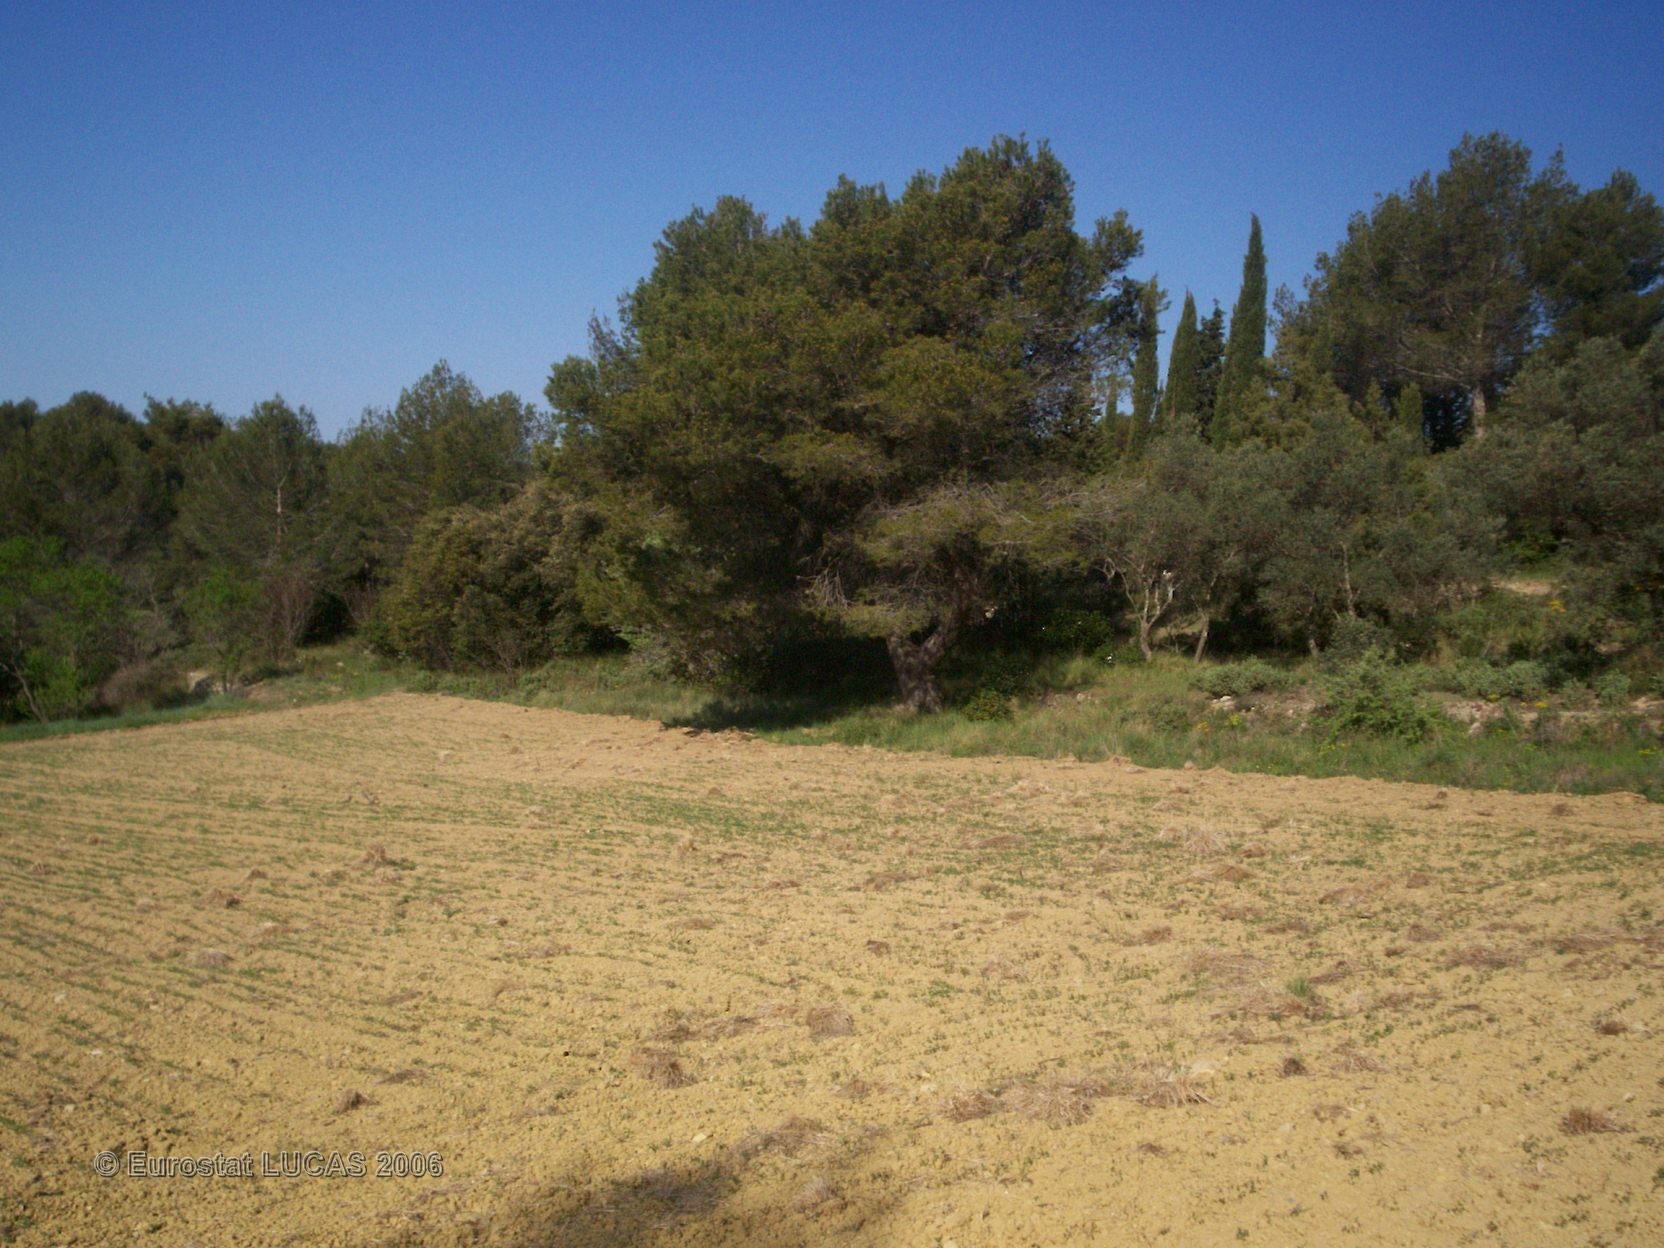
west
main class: Cropland
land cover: Other leguminous and mixtures for fodder
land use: Agriculture (excluding fallow land and kitchen gardens)
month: April
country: FR
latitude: 43.5502
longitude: 5.5412
